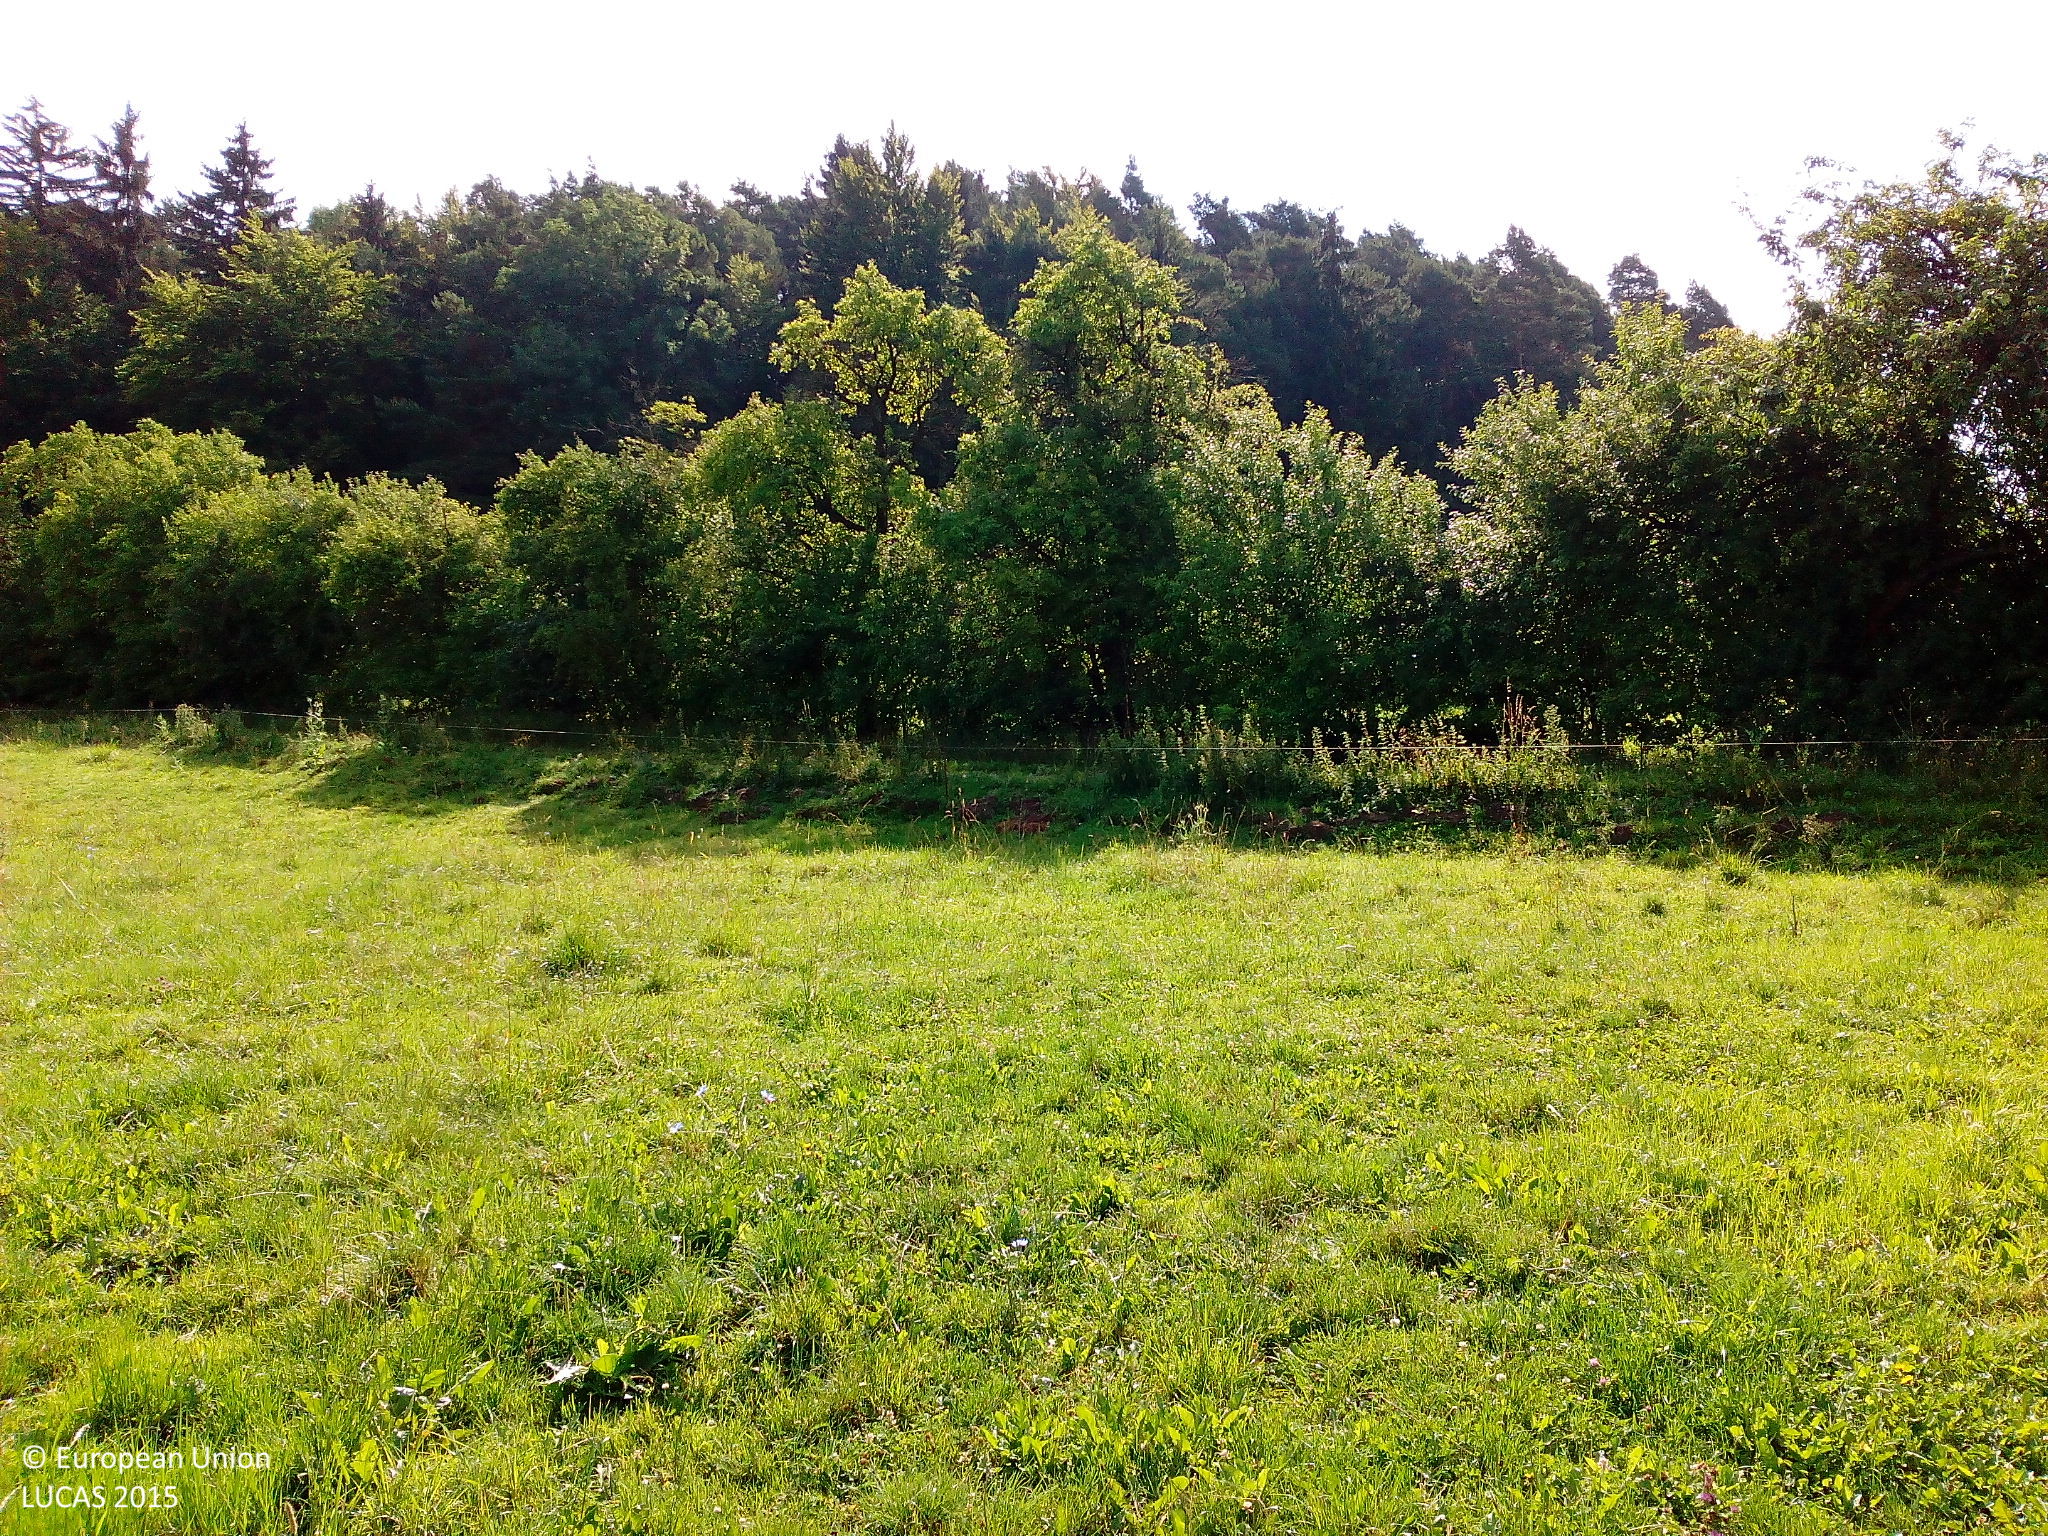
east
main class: Grassland
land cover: Grassland without tree/shrub cover
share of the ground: > 75 %
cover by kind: herbaceous plants 100 %
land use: Agriculture (excluding fallow land and kitchen gardens)
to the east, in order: Grassland without tree/shrub cover; Fences; Grass margins; Tracks; Grass margins; Broadleaved woodland; Grassland without tree/shrub cover; Pine dominated mixed woodland; Spruce dominated mixed woodland; Fences; Grassland without tree/shrub cover; Single bushes/trees; Grassland without tree/shrub cover
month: July
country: DE
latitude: 50.6517
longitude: 9.9010
